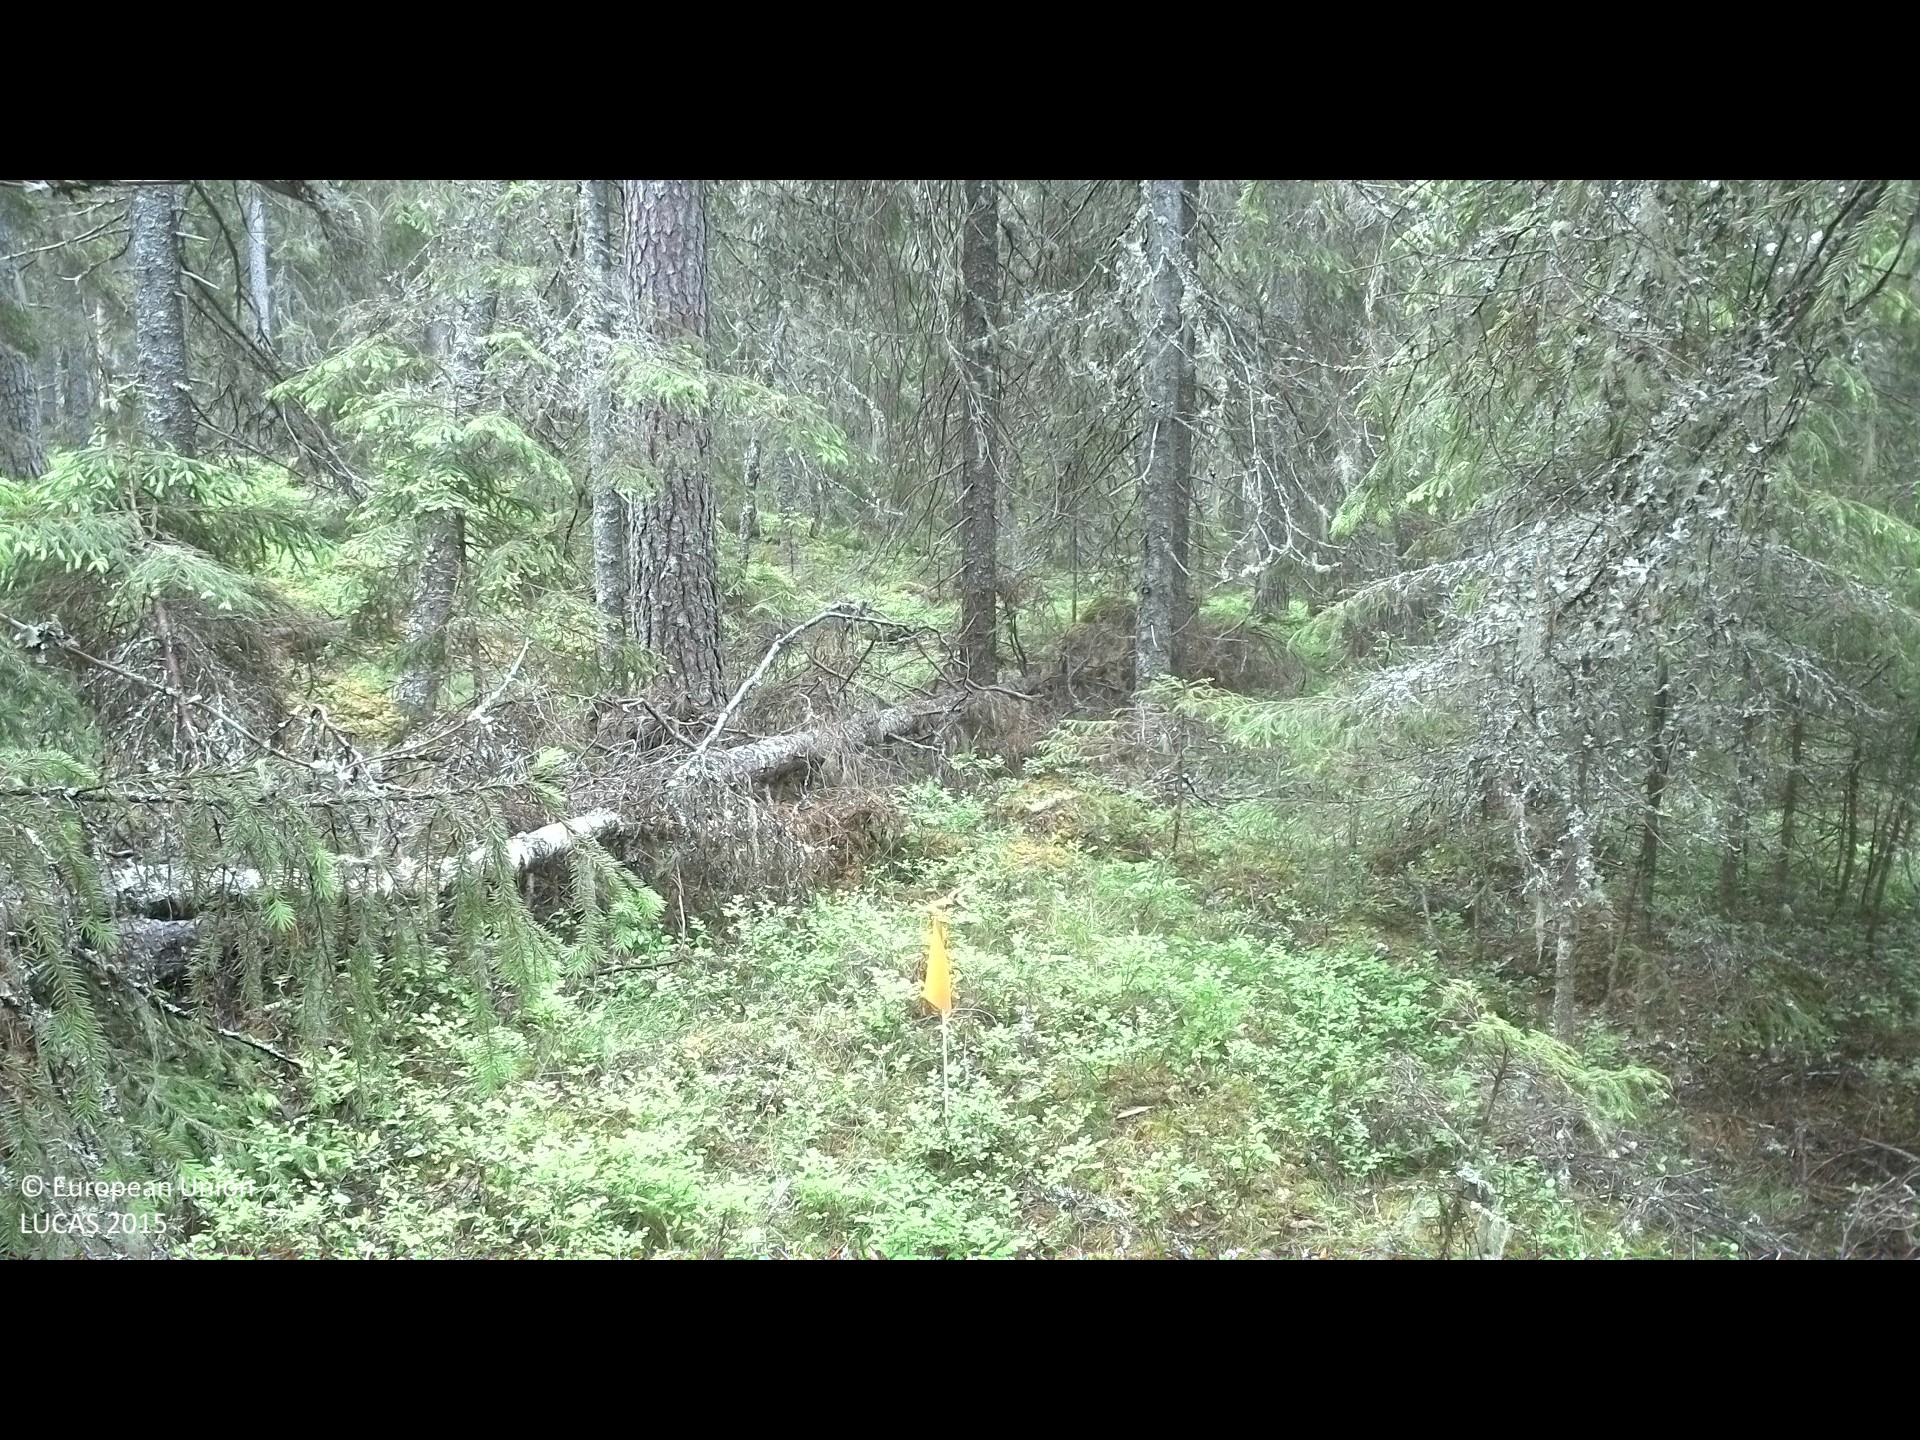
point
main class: Woodland
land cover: Spruce dominated coniferous woodland
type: boreal forest
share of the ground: 50 - 75 %
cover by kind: coniferous forest trees 50 %, shrubs 25 %, lichens and mosses 20 %, herbaceous plants 5 %
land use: Forestry
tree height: > 5 m
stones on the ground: 25 - 50 %
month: June
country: SE
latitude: 62.0565
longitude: 16.8874
